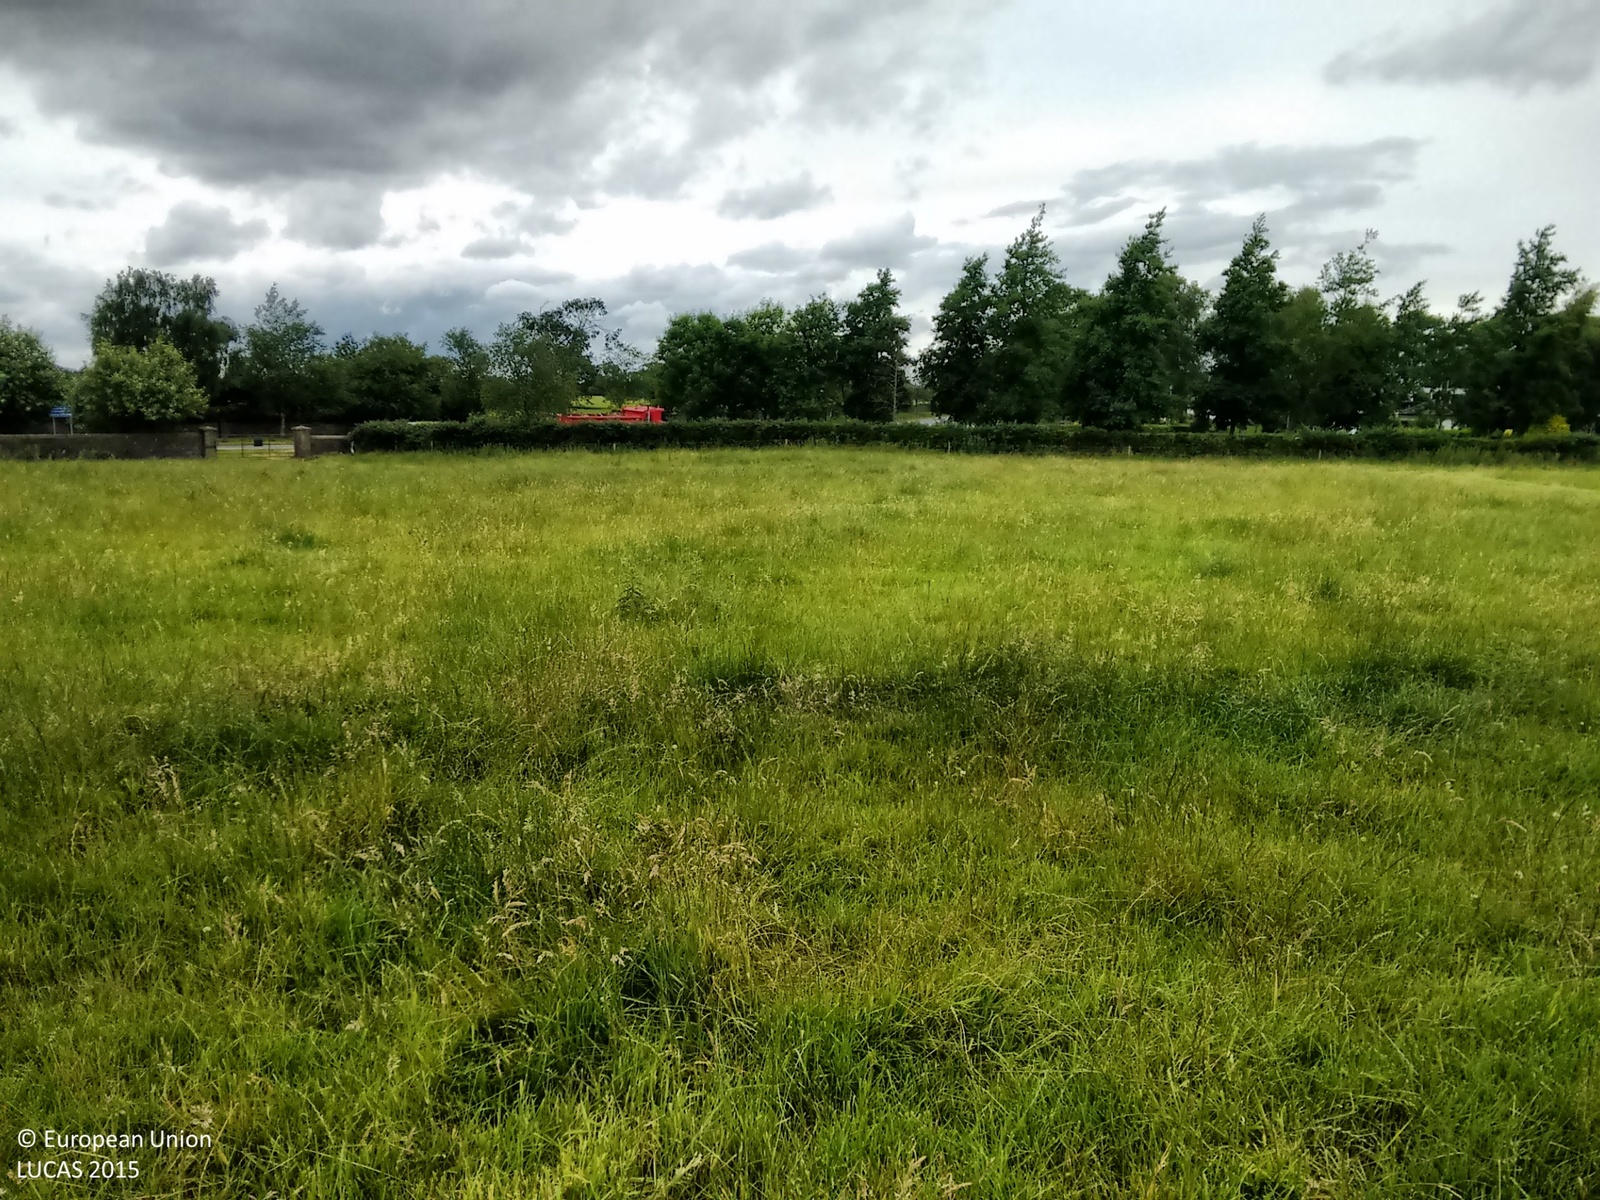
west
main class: Grassland
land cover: Grassland without tree/shrub cover
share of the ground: > 75 %
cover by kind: herbaceous plants 100 %
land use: Agriculture (excluding fallow land and kitchen gardens)
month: July
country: IE
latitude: 52.5518
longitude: -7.3961
